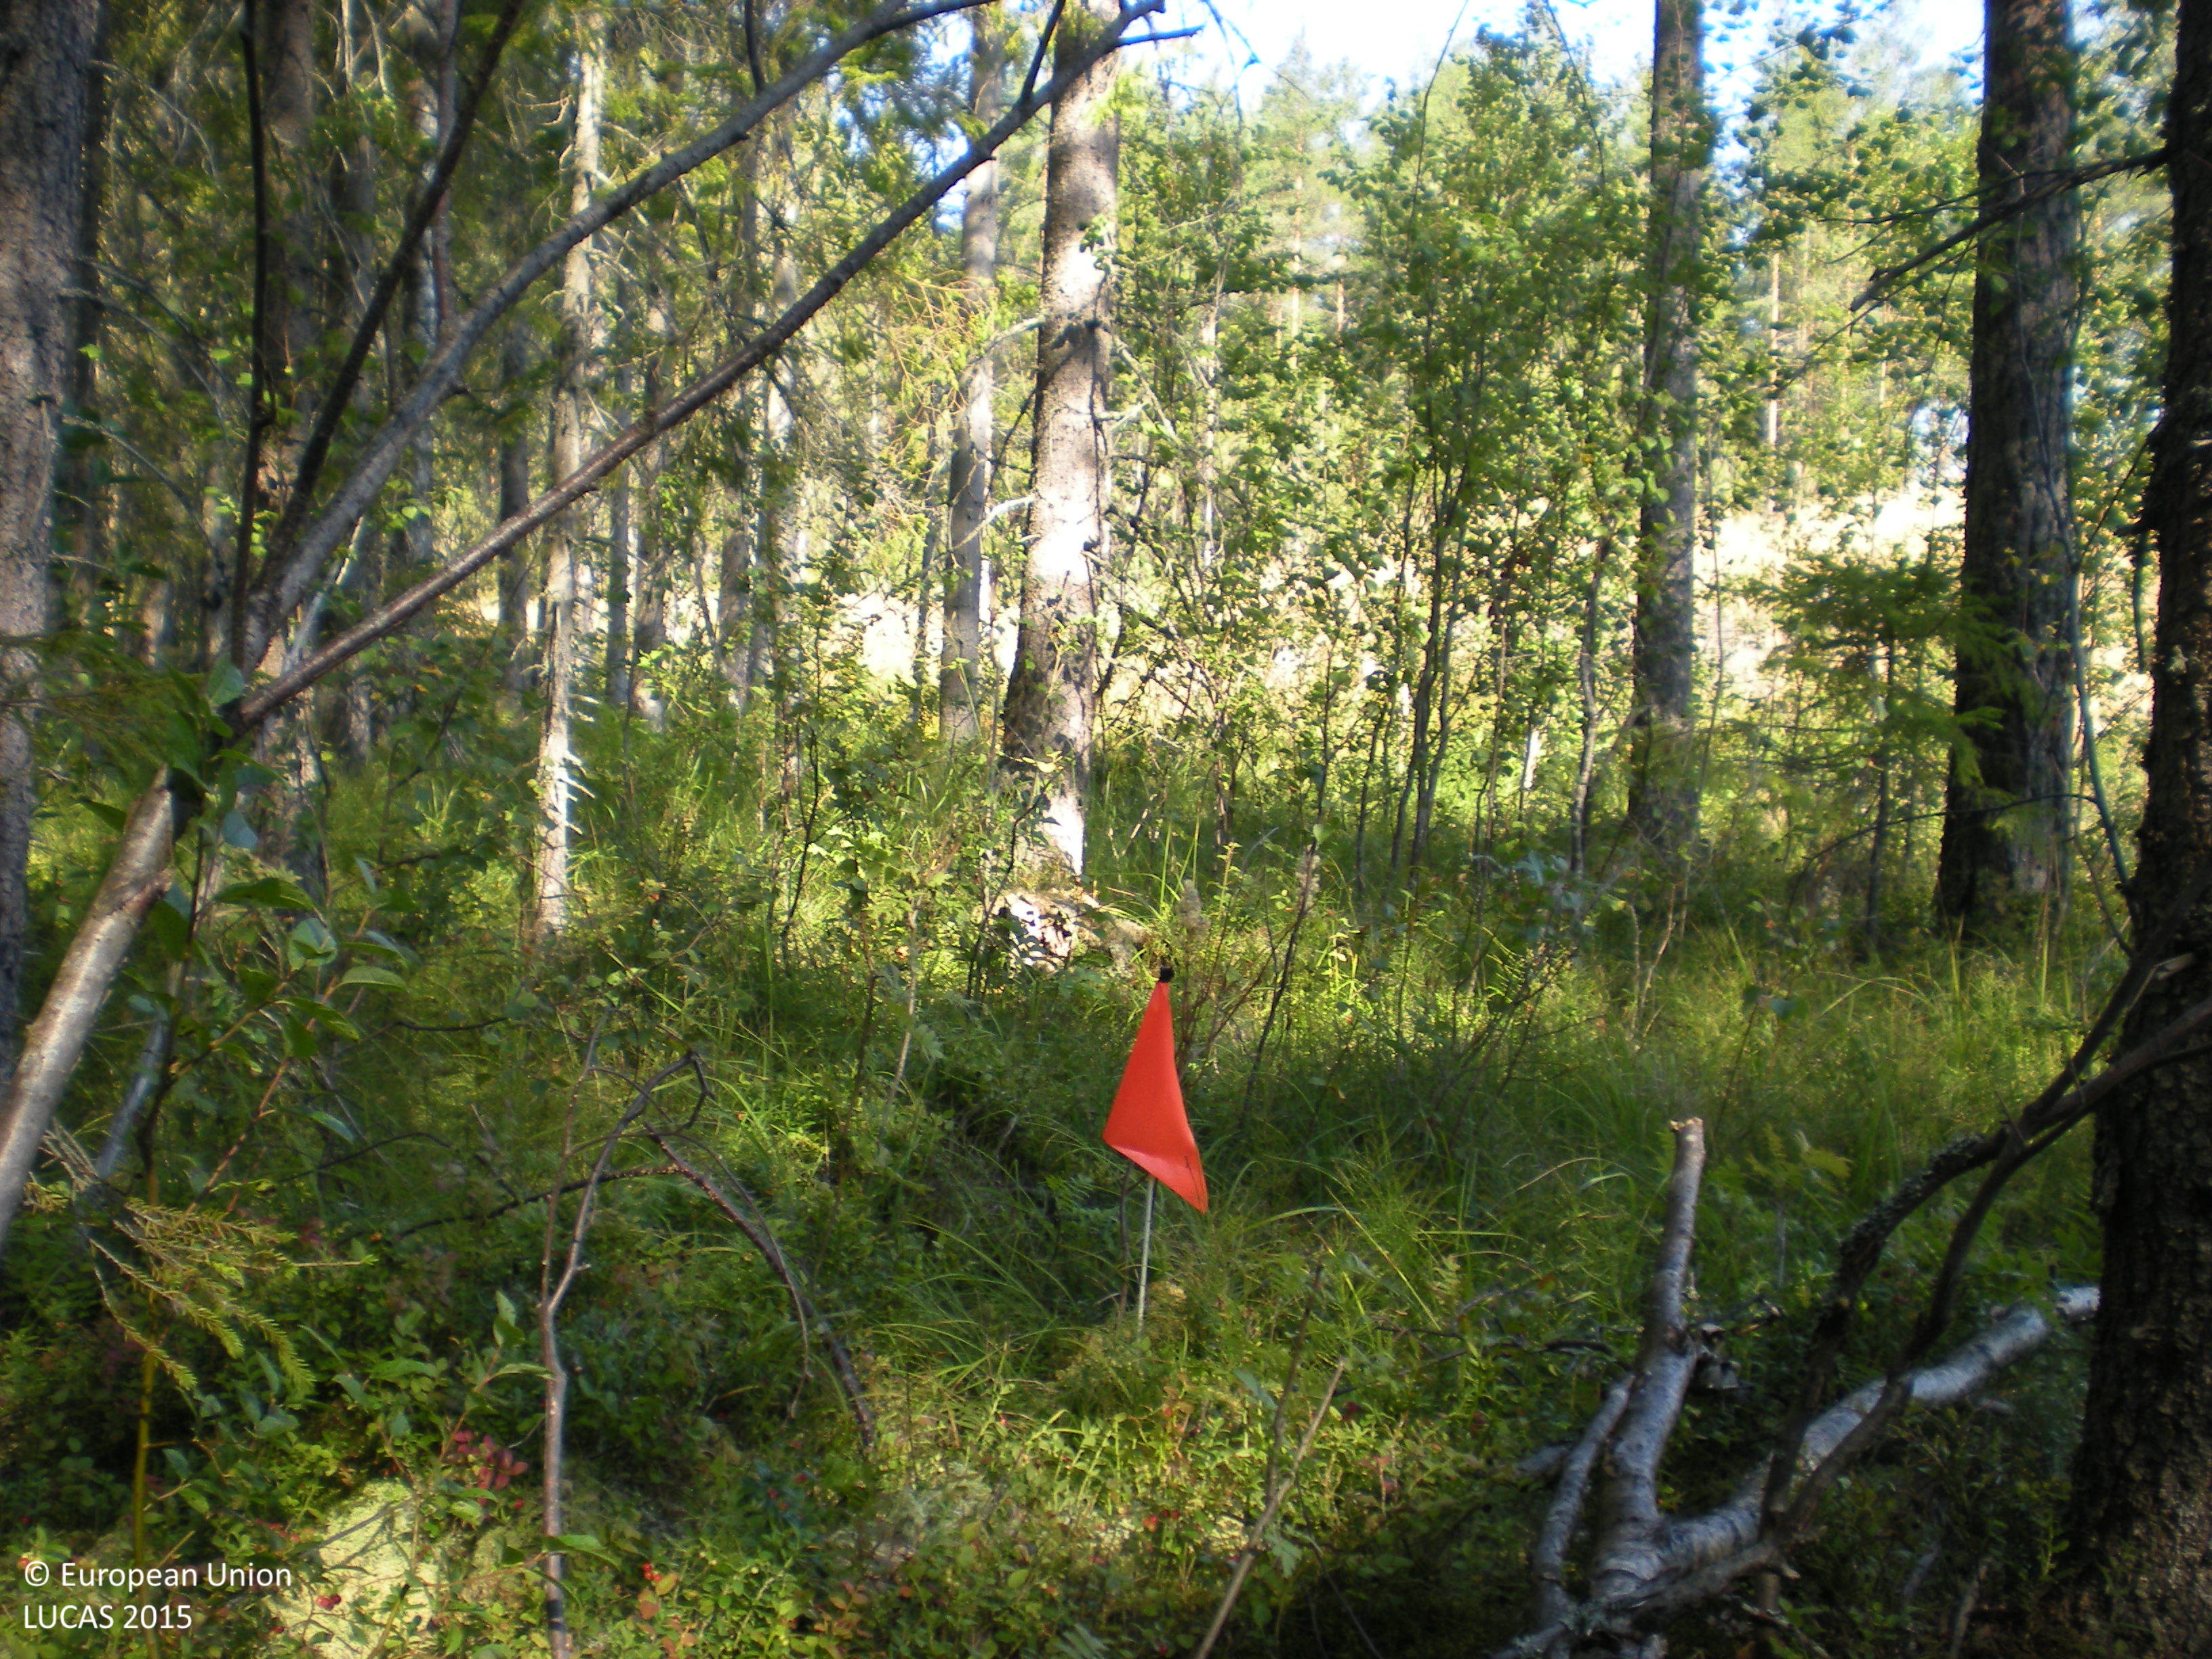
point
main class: Woodland
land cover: Other mixed woodland
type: boreal forest
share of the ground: 50 - 75 %
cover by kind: coniferous forest trees 50 %, broadleaved forest trees 20 %, shrubs 20 %, herbaceous plants 5 %, lichens and mosses 5 %
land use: Forestry
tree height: > 5 m
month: August
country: SE
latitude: 60.5899
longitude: 17.2739
